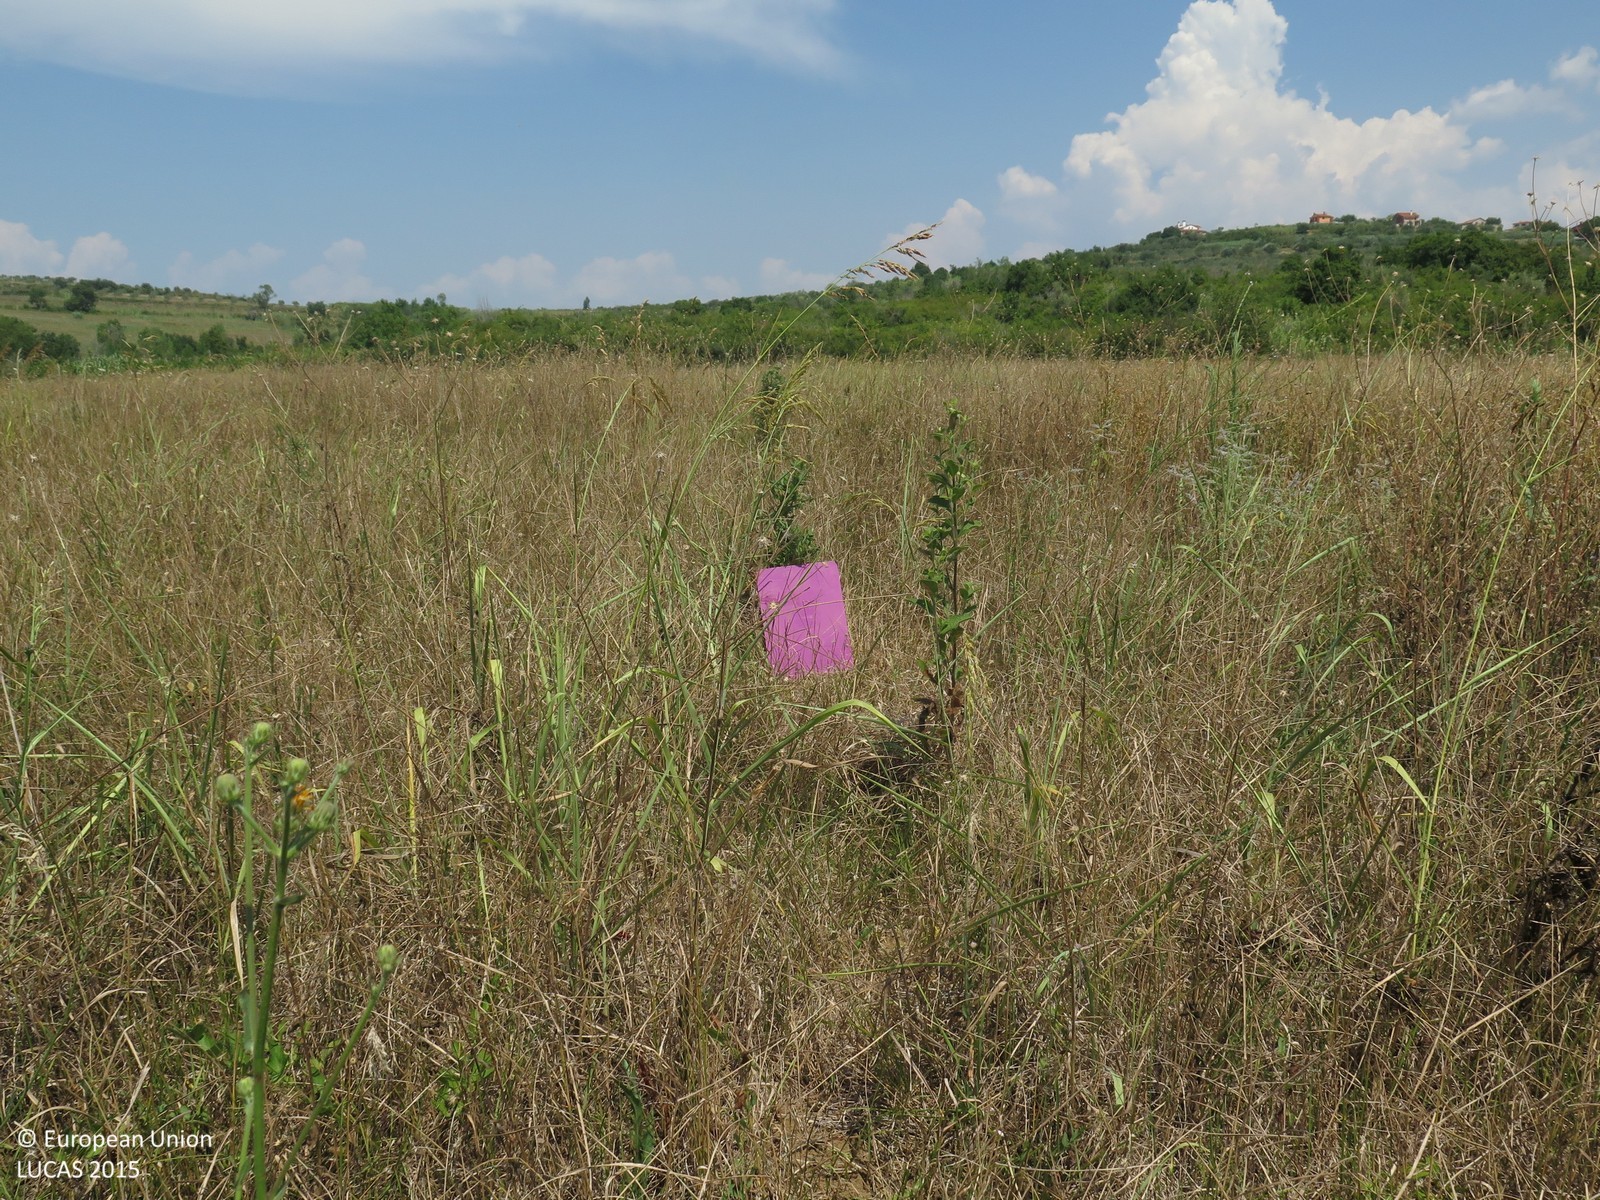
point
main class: Grassland
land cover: Spontaneously vegetated surfaces
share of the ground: > 75 %
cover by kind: herbaceous plants 95 %, shrubs 5 %
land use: Fallow land
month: July
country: HR
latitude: 45.4057
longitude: 13.6365
